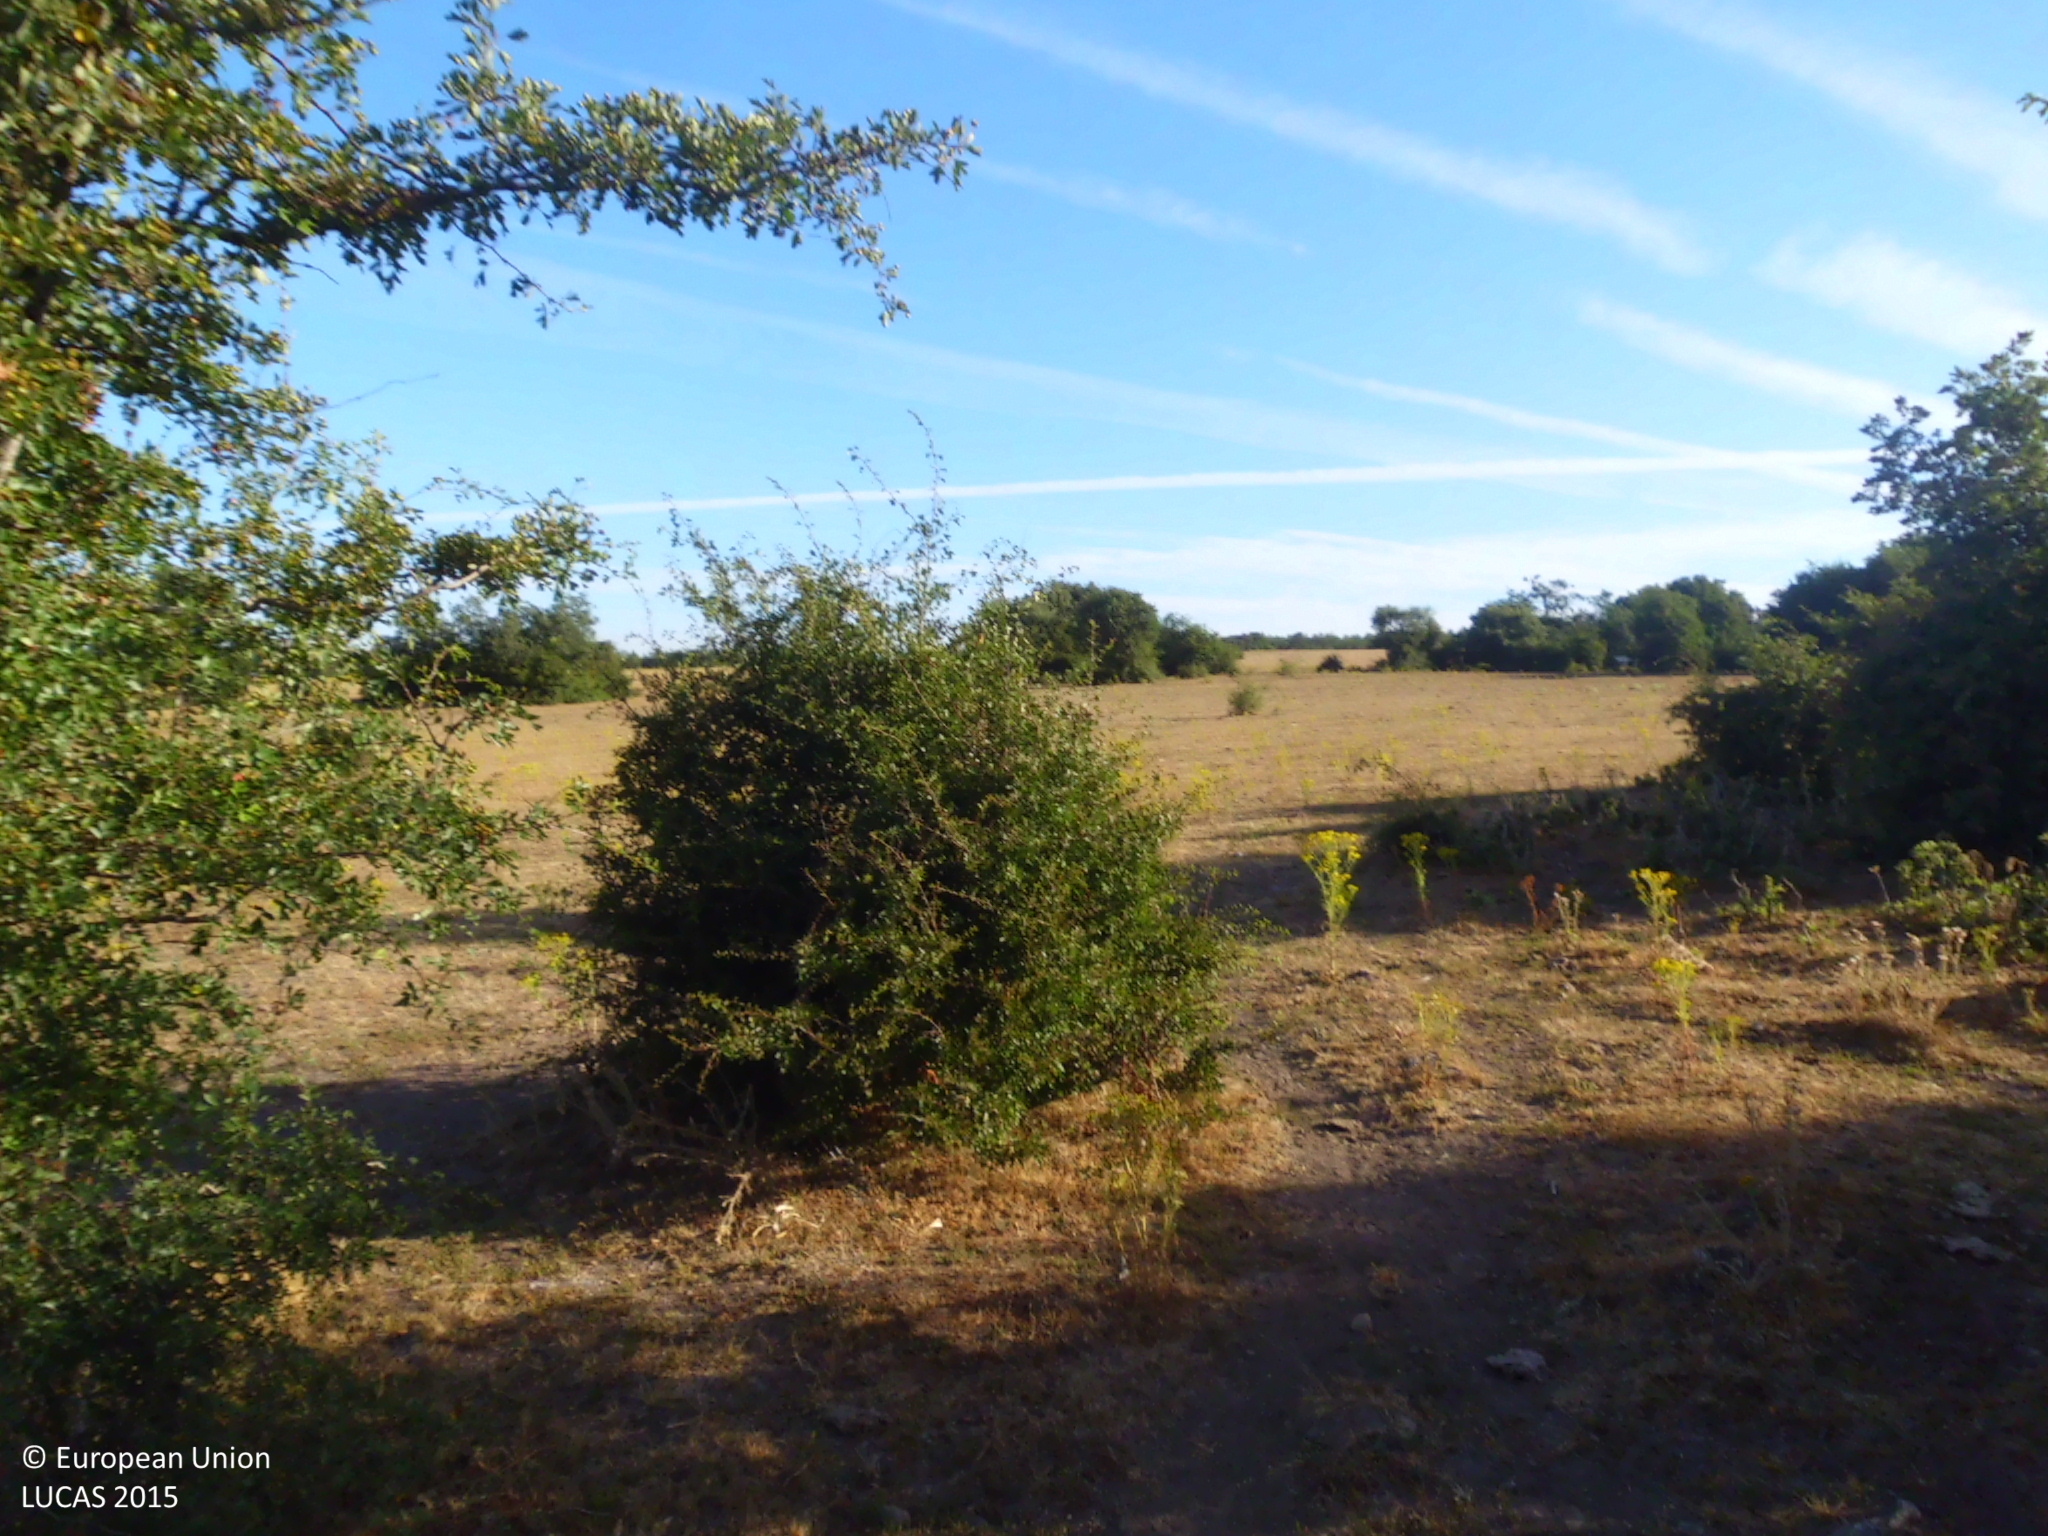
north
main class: Grassland
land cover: Grassland with sparse tree/shrub cover
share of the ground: 25 - 50 %
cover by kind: unconsolidated bare surface 50 %, herbaceous plants 40 %, broadleaved forest trees 5 %, shrubs 5 %
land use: Agriculture (excluding fallow land and kitchen gardens)
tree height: < 5 m
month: July
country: ES
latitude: 42.6995
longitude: -4.2709
